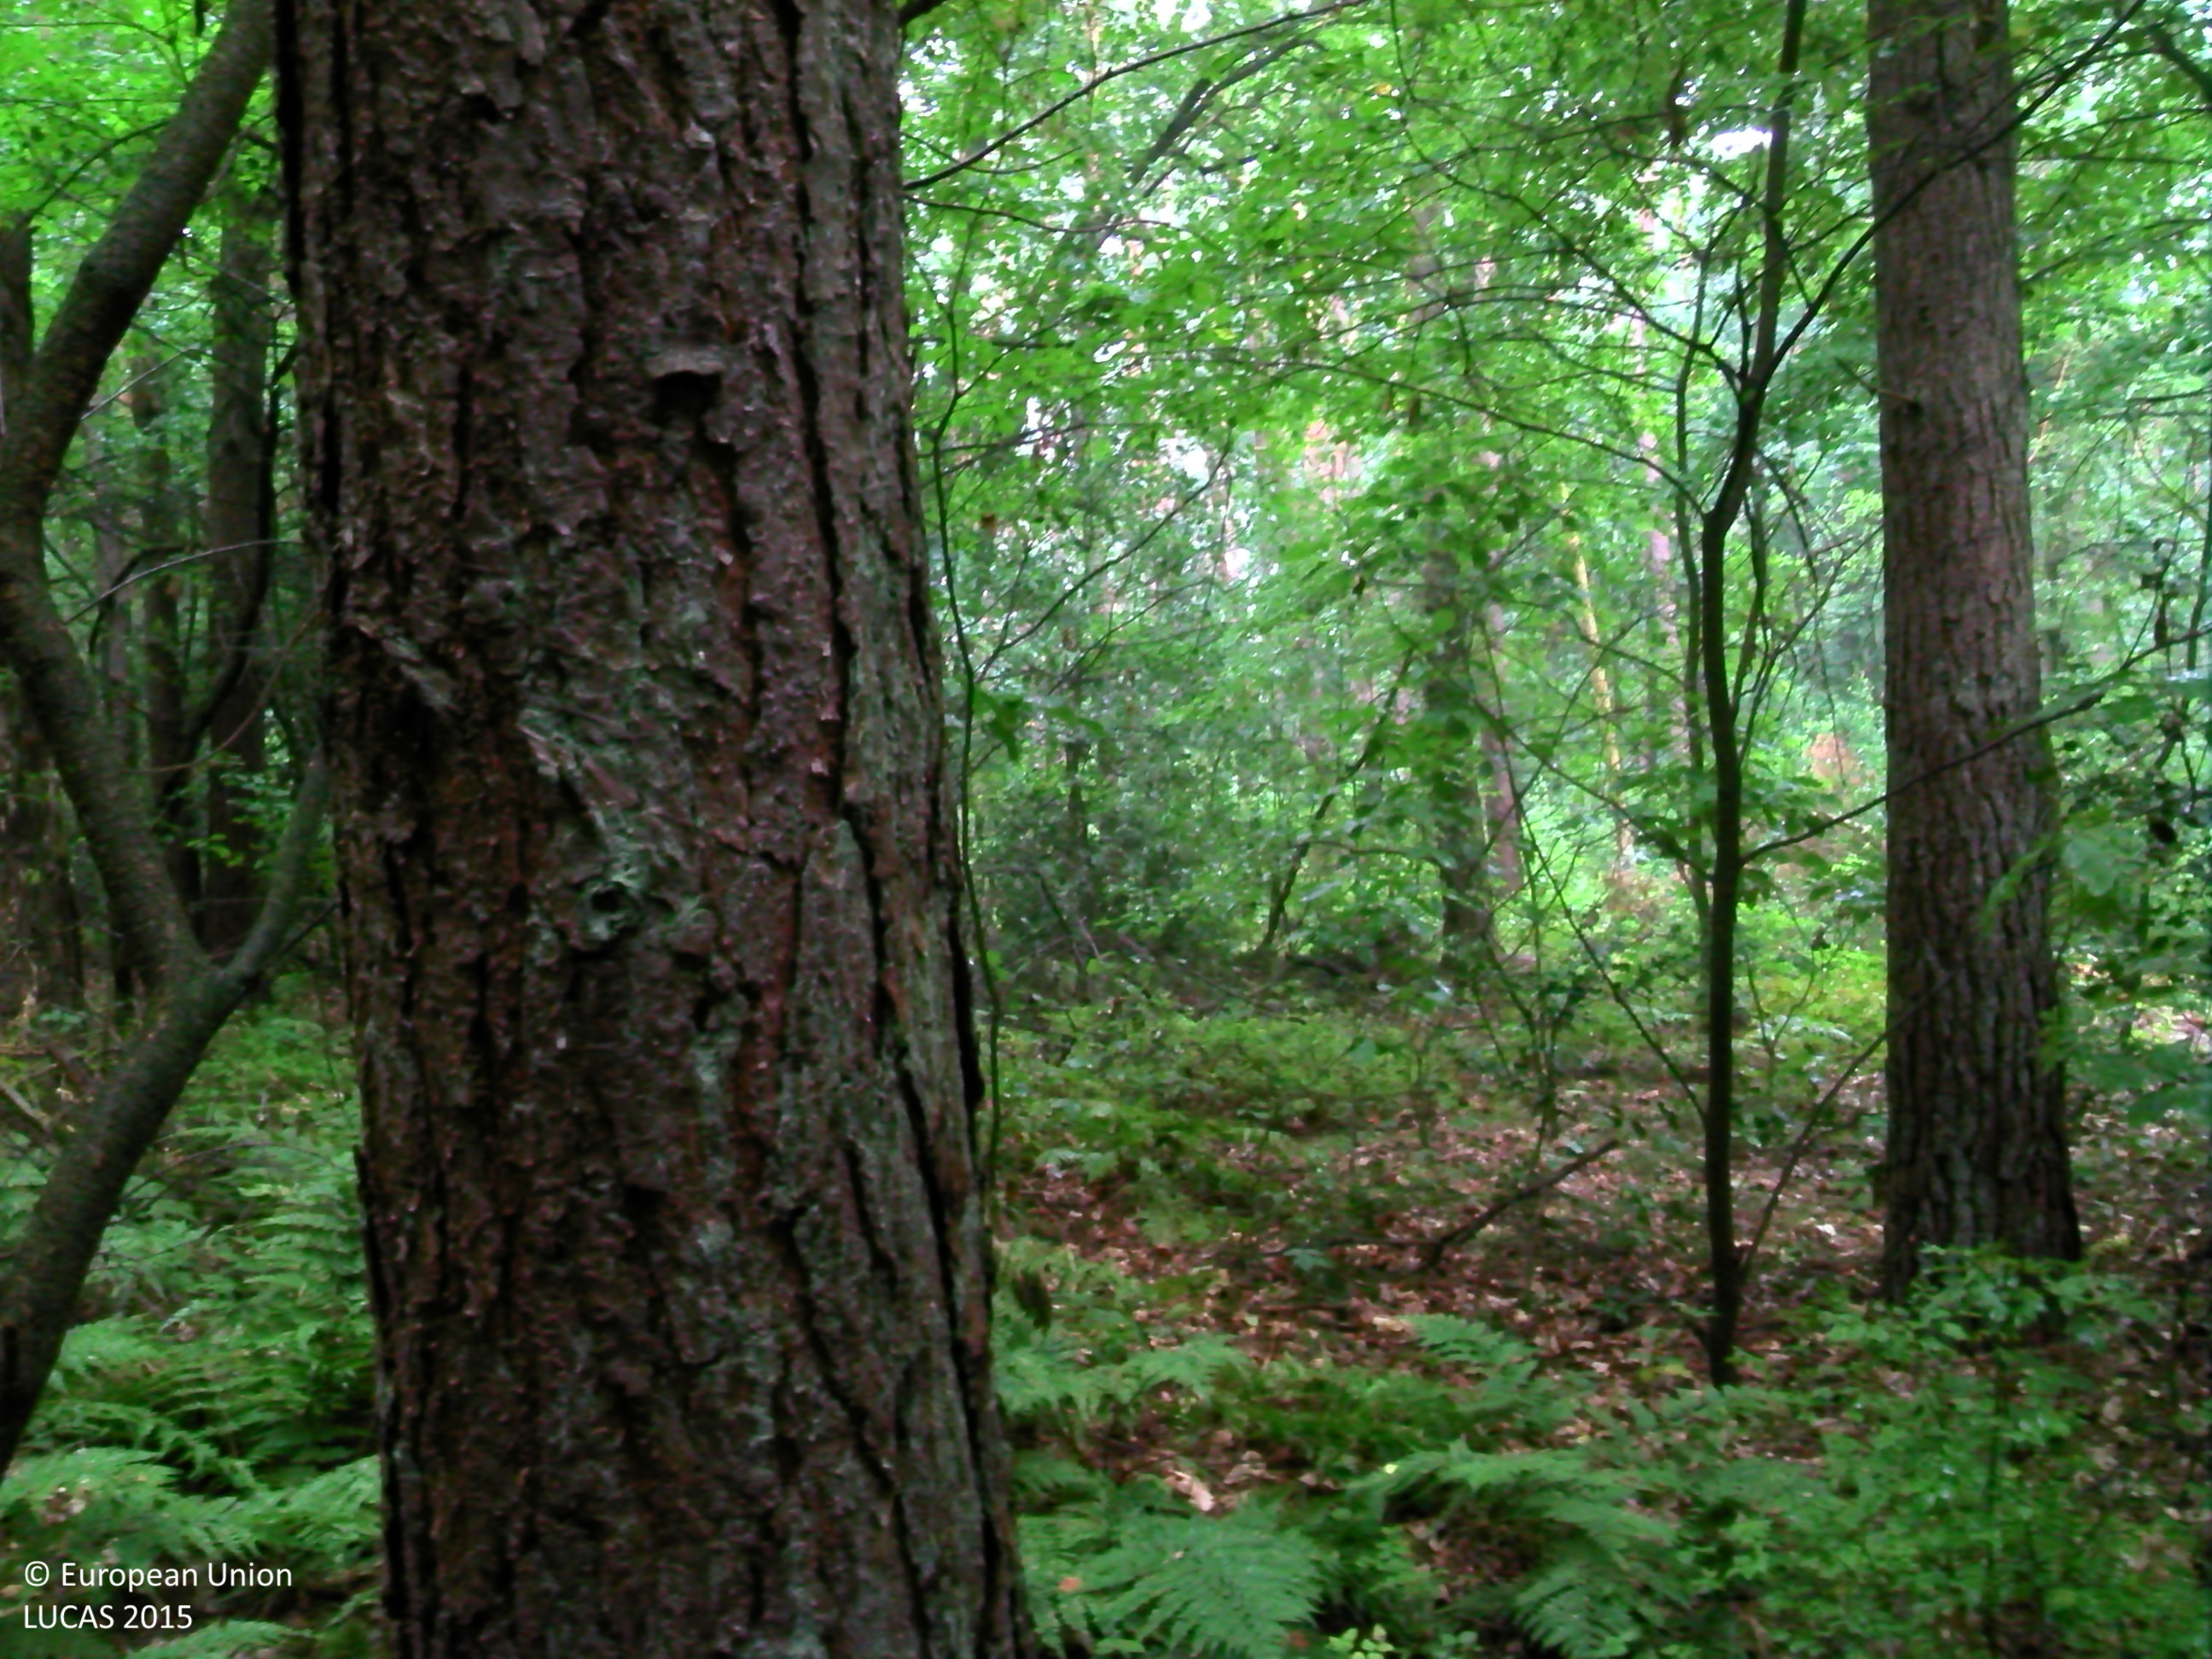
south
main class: Woodland
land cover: Pine dominated mixed woodland
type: hemiboreal forest and nemoral coniferous forest and mixed broadleaved-coniferous forest
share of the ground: > 75 %
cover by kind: coniferous forest trees 70 %, broadleaved forest trees 30 %
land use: Forestry
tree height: > 5 m
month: August
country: BE
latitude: 50.9446
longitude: 5.5719
